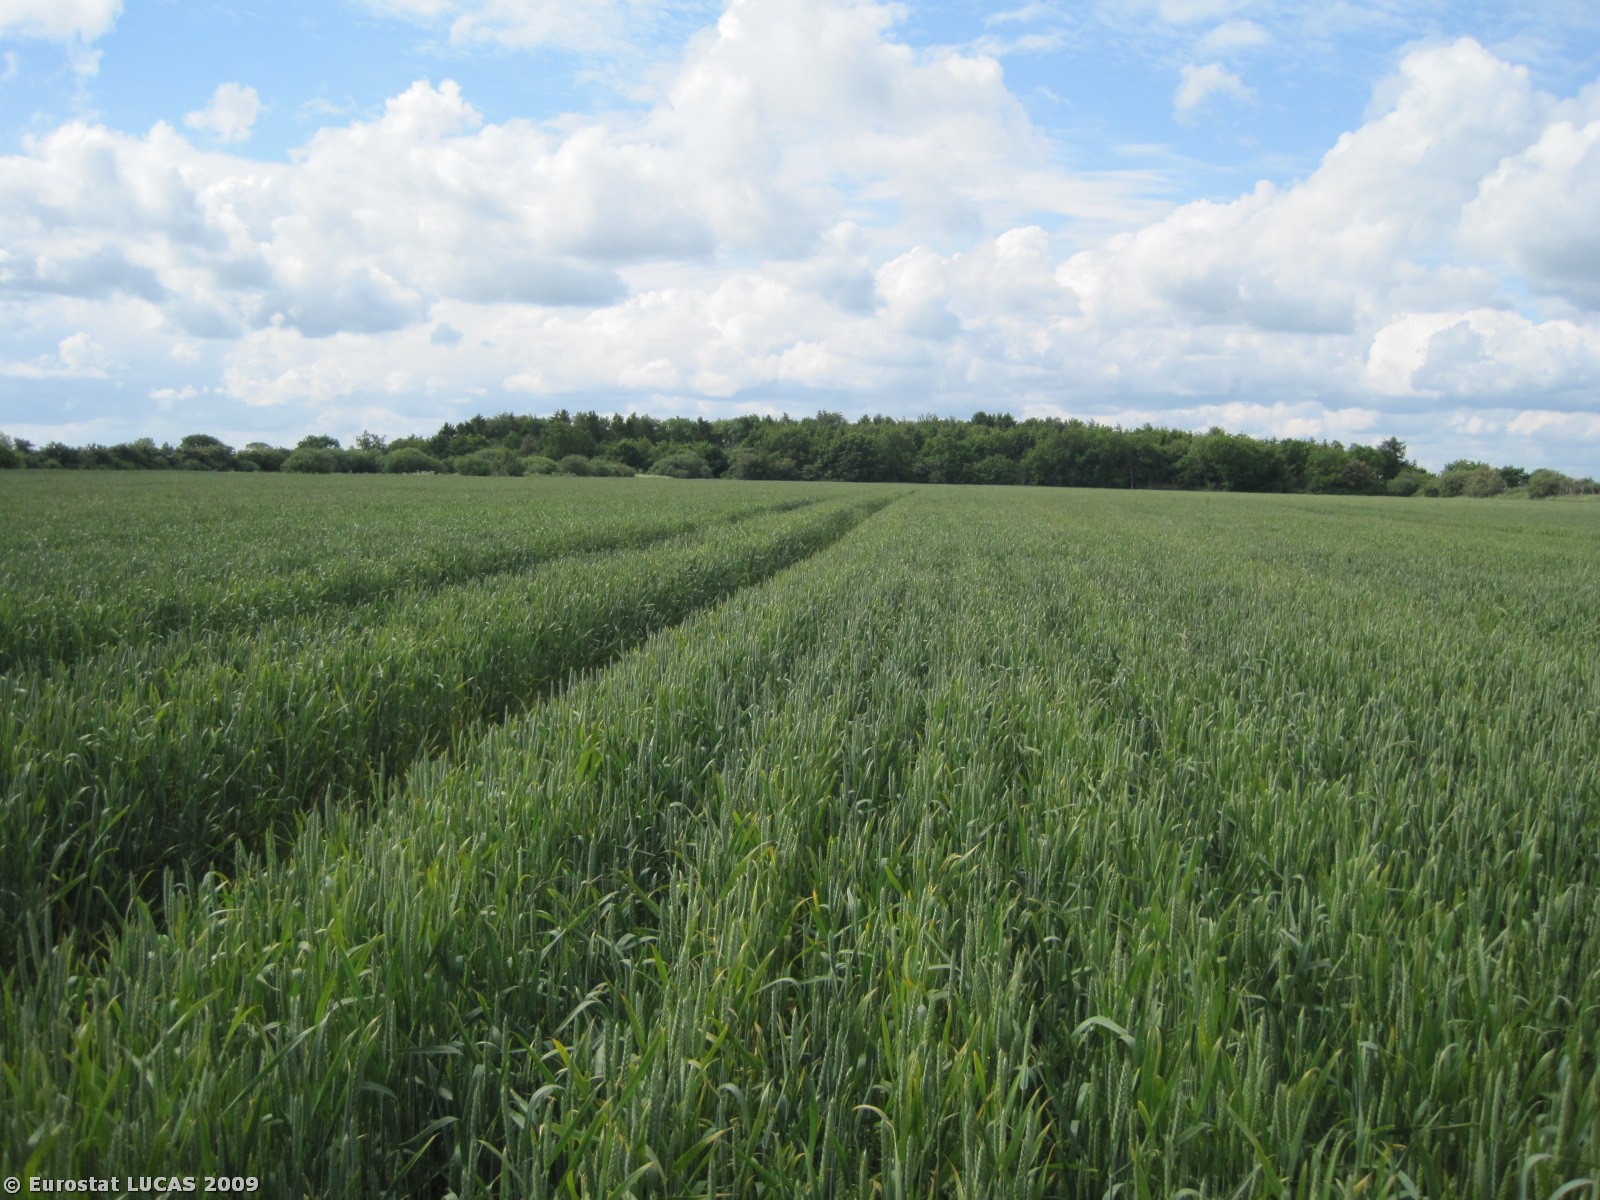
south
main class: Cropland
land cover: Common wheat
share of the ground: > 75 %
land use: Agriculture (excluding fallow land and kitchen gardens)
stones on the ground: < 10 %
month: June
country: DK
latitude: 57.0505
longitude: 10.1811
